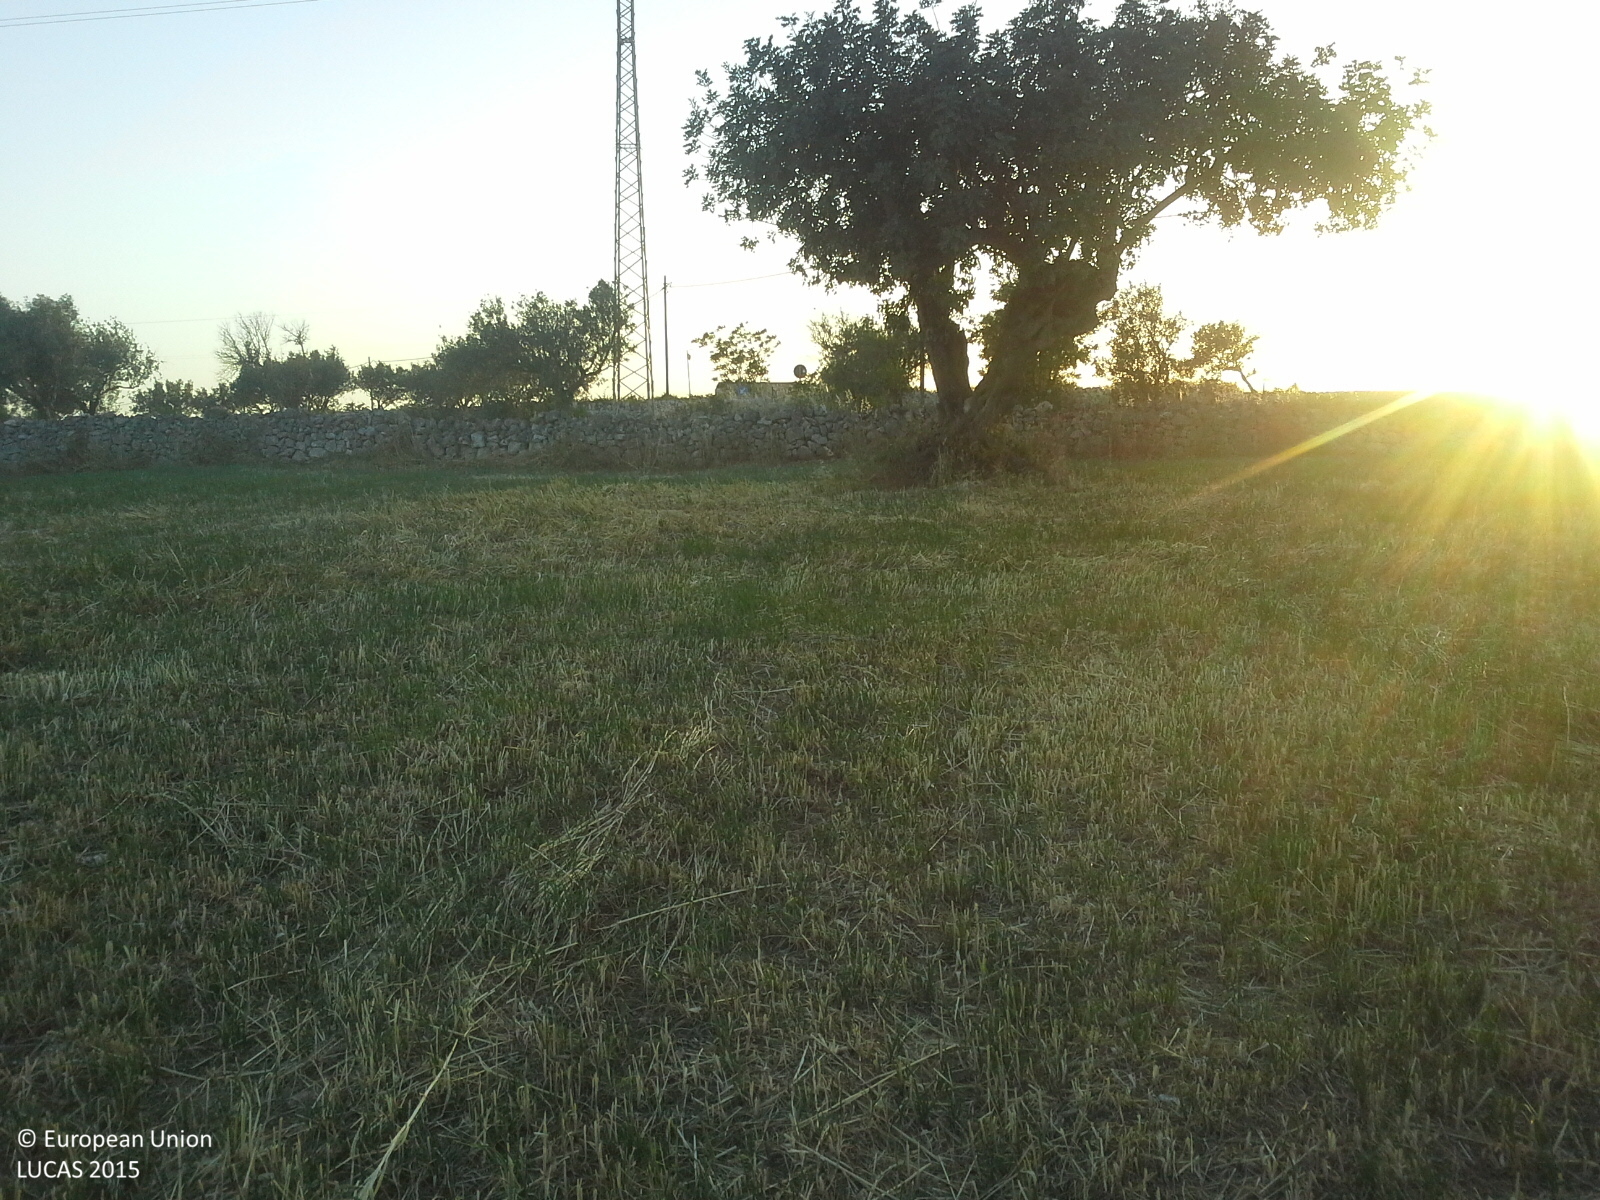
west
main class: Cropland
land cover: Mixed cereals for fodder
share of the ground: > 75 %
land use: Agriculture (excluding fallow land and kitchen gardens)
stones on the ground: < 10 %
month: May
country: IT
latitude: 36.7888
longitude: 14.8134
